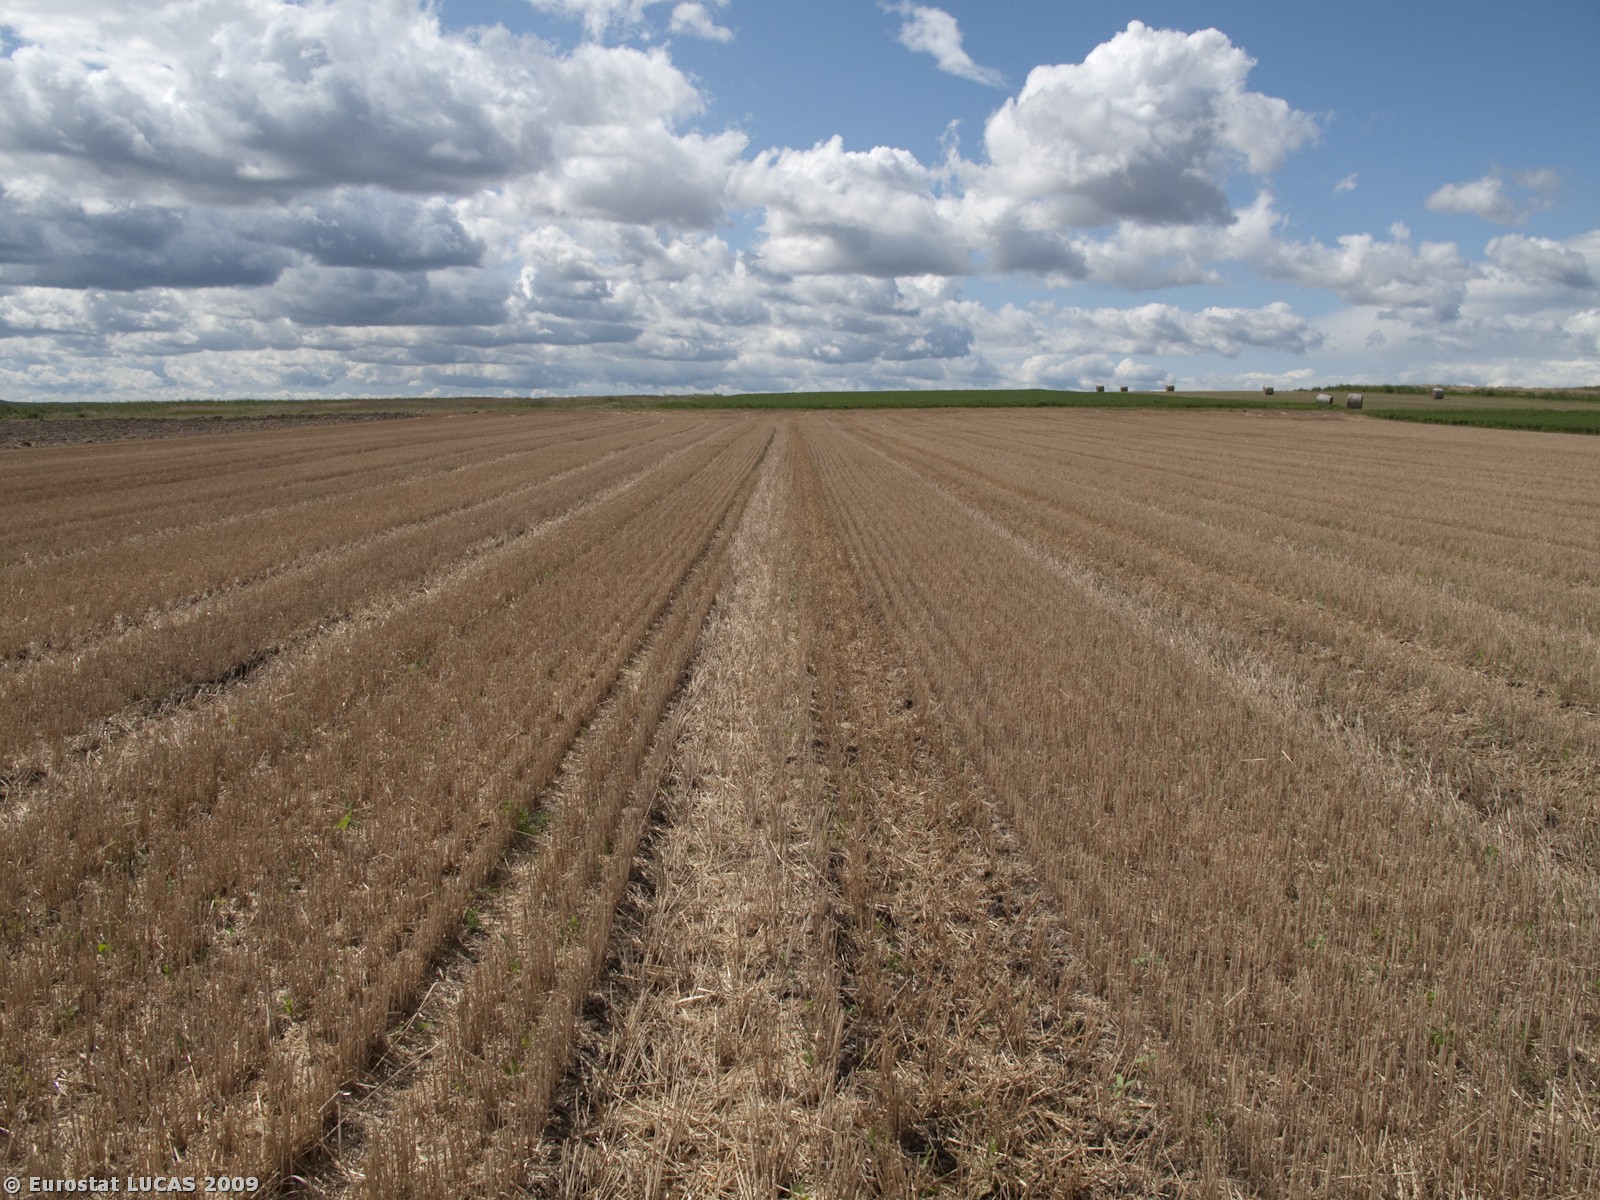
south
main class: Cropland
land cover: Barley
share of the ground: < 10 %
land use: Agriculture (excluding fallow land and kitchen gardens)
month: July
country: AT
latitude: 48.6424
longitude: 15.9079
